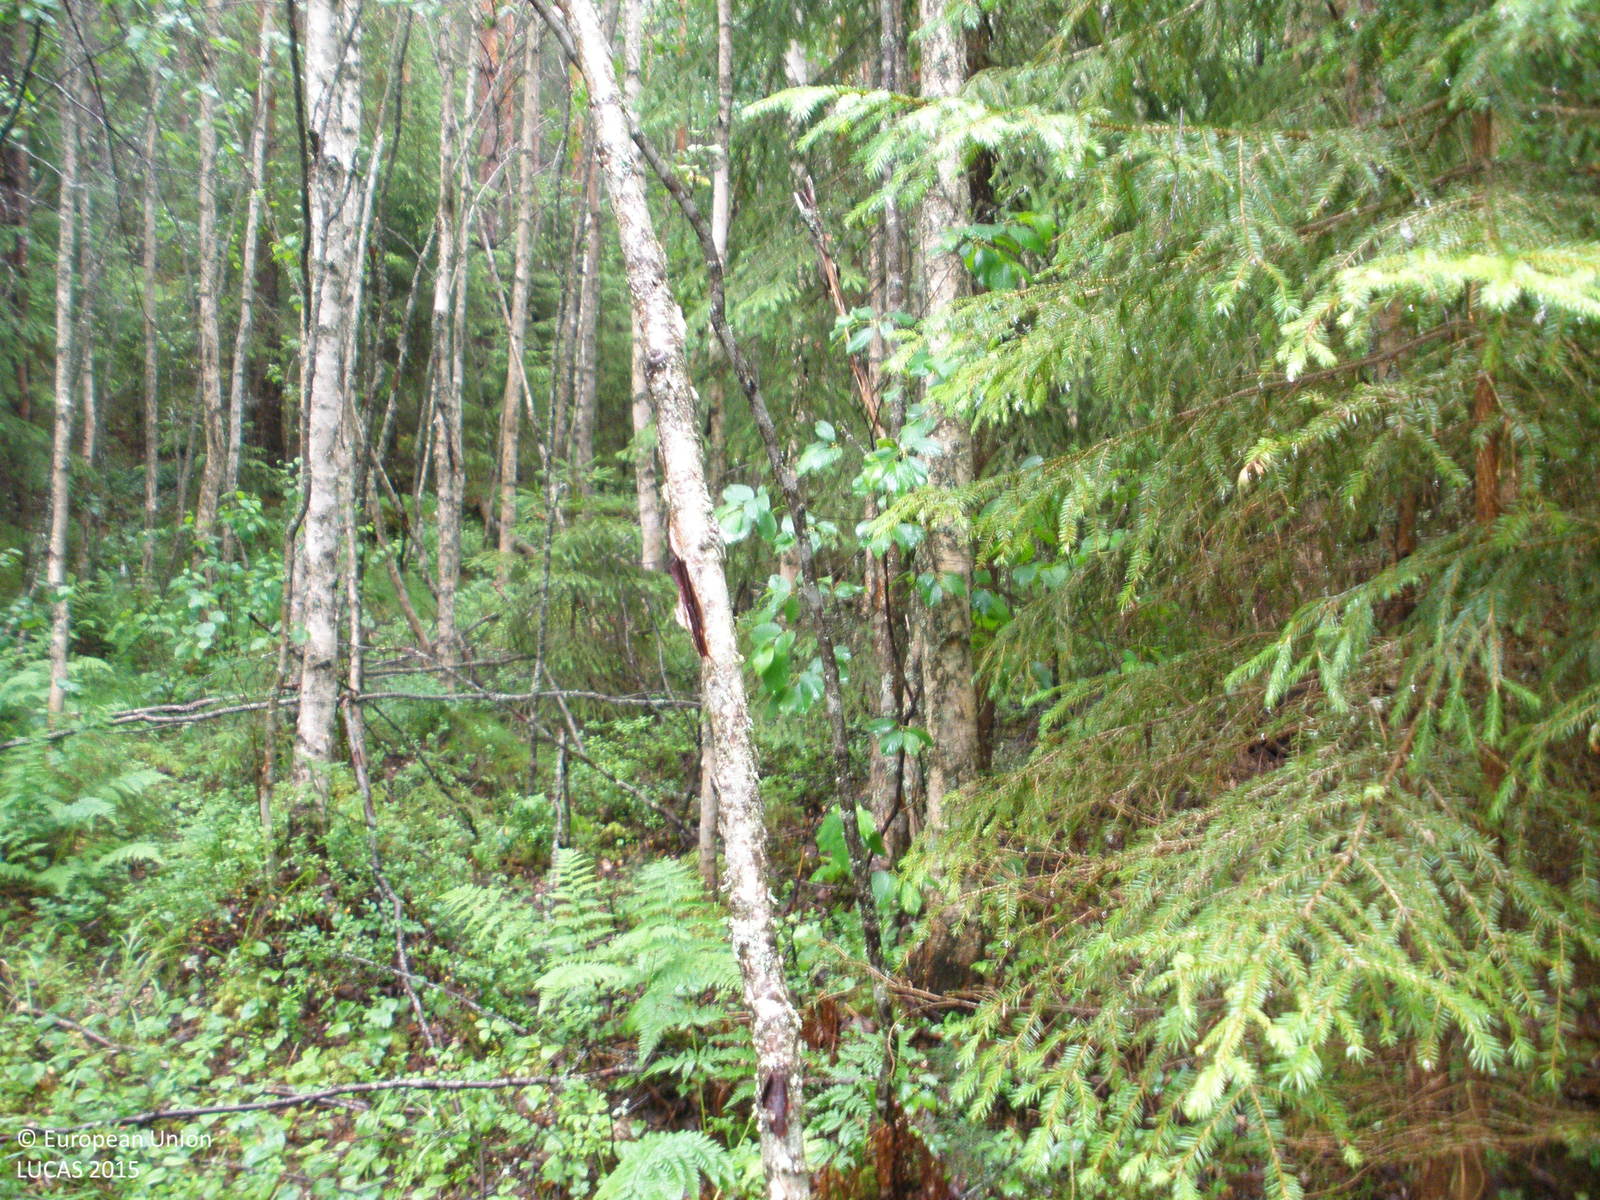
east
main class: Woodland
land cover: Spruce dominated mixed woodland
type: boreal forest
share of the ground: > 75 %
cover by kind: coniferous forest trees 40 %, broadleaved forest trees 35 %, herbaceous plants 15 %, lichens and mosses 5 %
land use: Forestry
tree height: > 5 m
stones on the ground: < 10 %
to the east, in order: Spruce dominated mixed woodland; Pine dominated coniferous woodland; Broadleaved woodland; Other coniferous woodland; Spruce dominated mixed woodland; Other mixed woodland; Other coniferous woodland
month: July
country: FI
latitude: 61.3956
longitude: 23.6961
